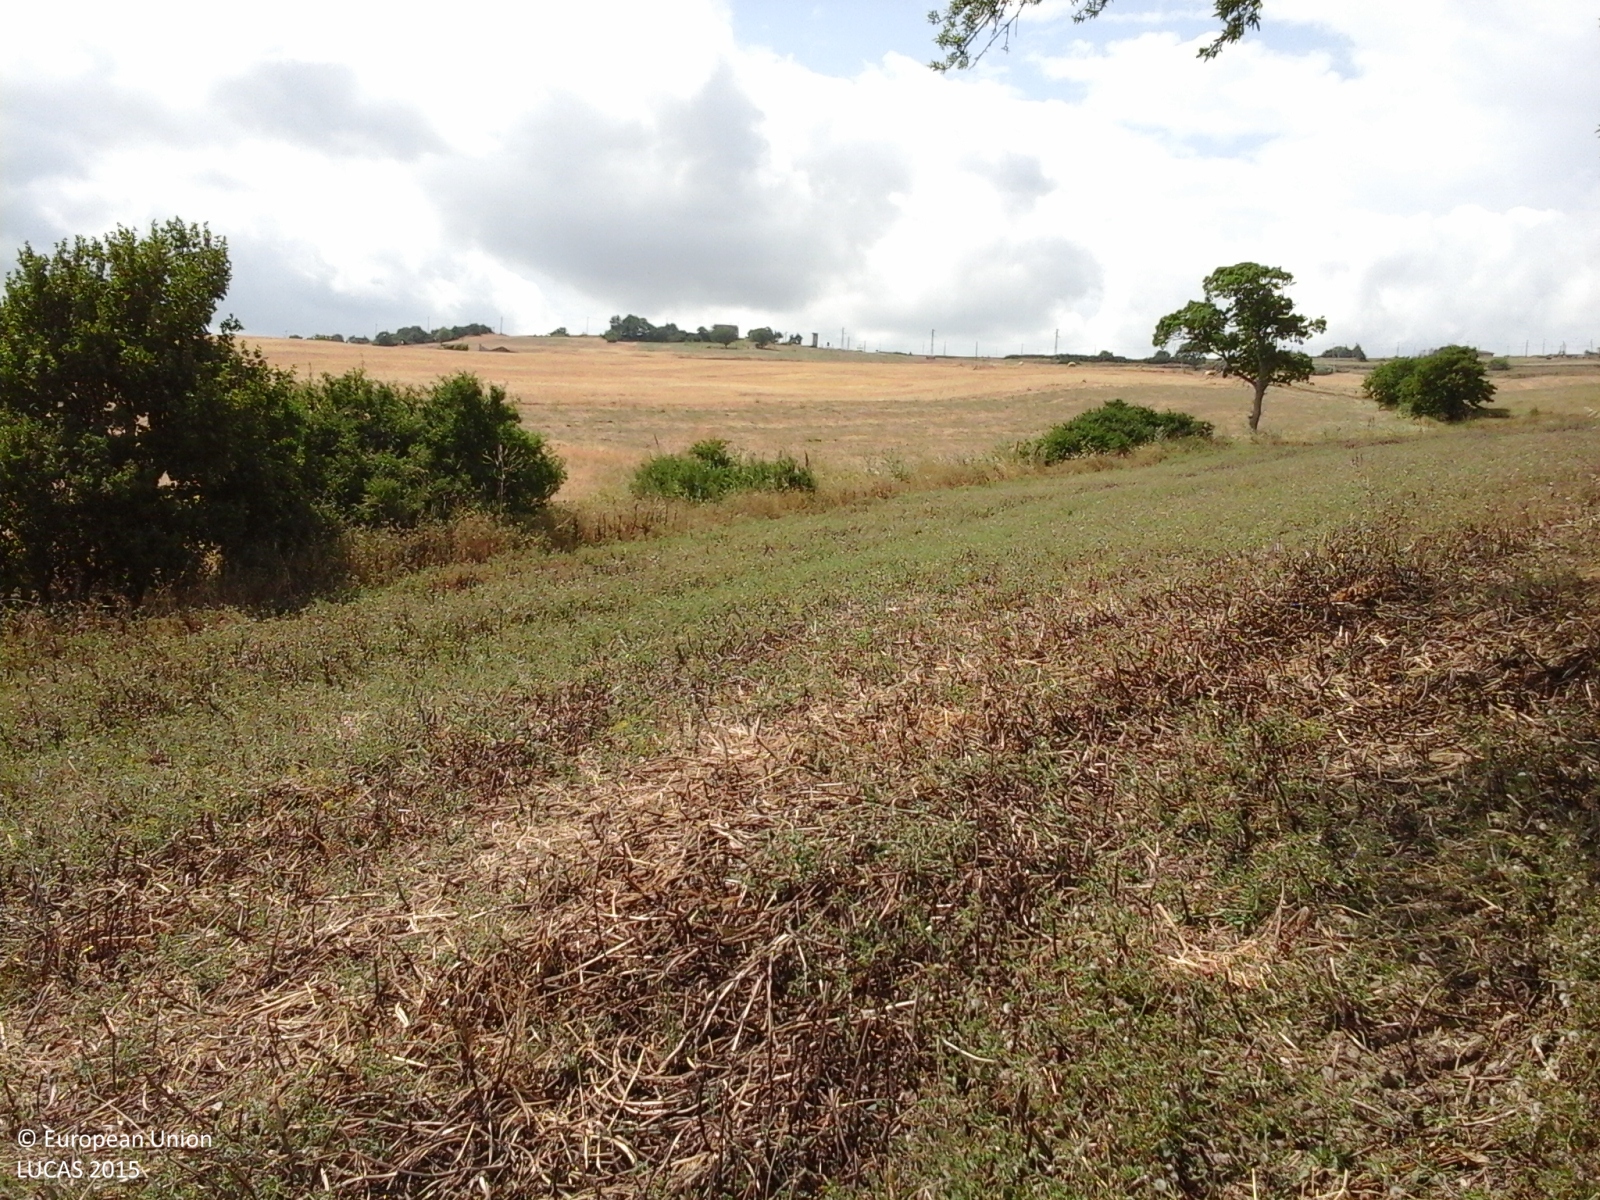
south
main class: Cropland
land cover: Dry pulses
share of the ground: > 75 %
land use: Agriculture (excluding fallow land and kitchen gardens)
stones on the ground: < 10 %
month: July
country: IT
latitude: 41.8035
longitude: 14.6906
